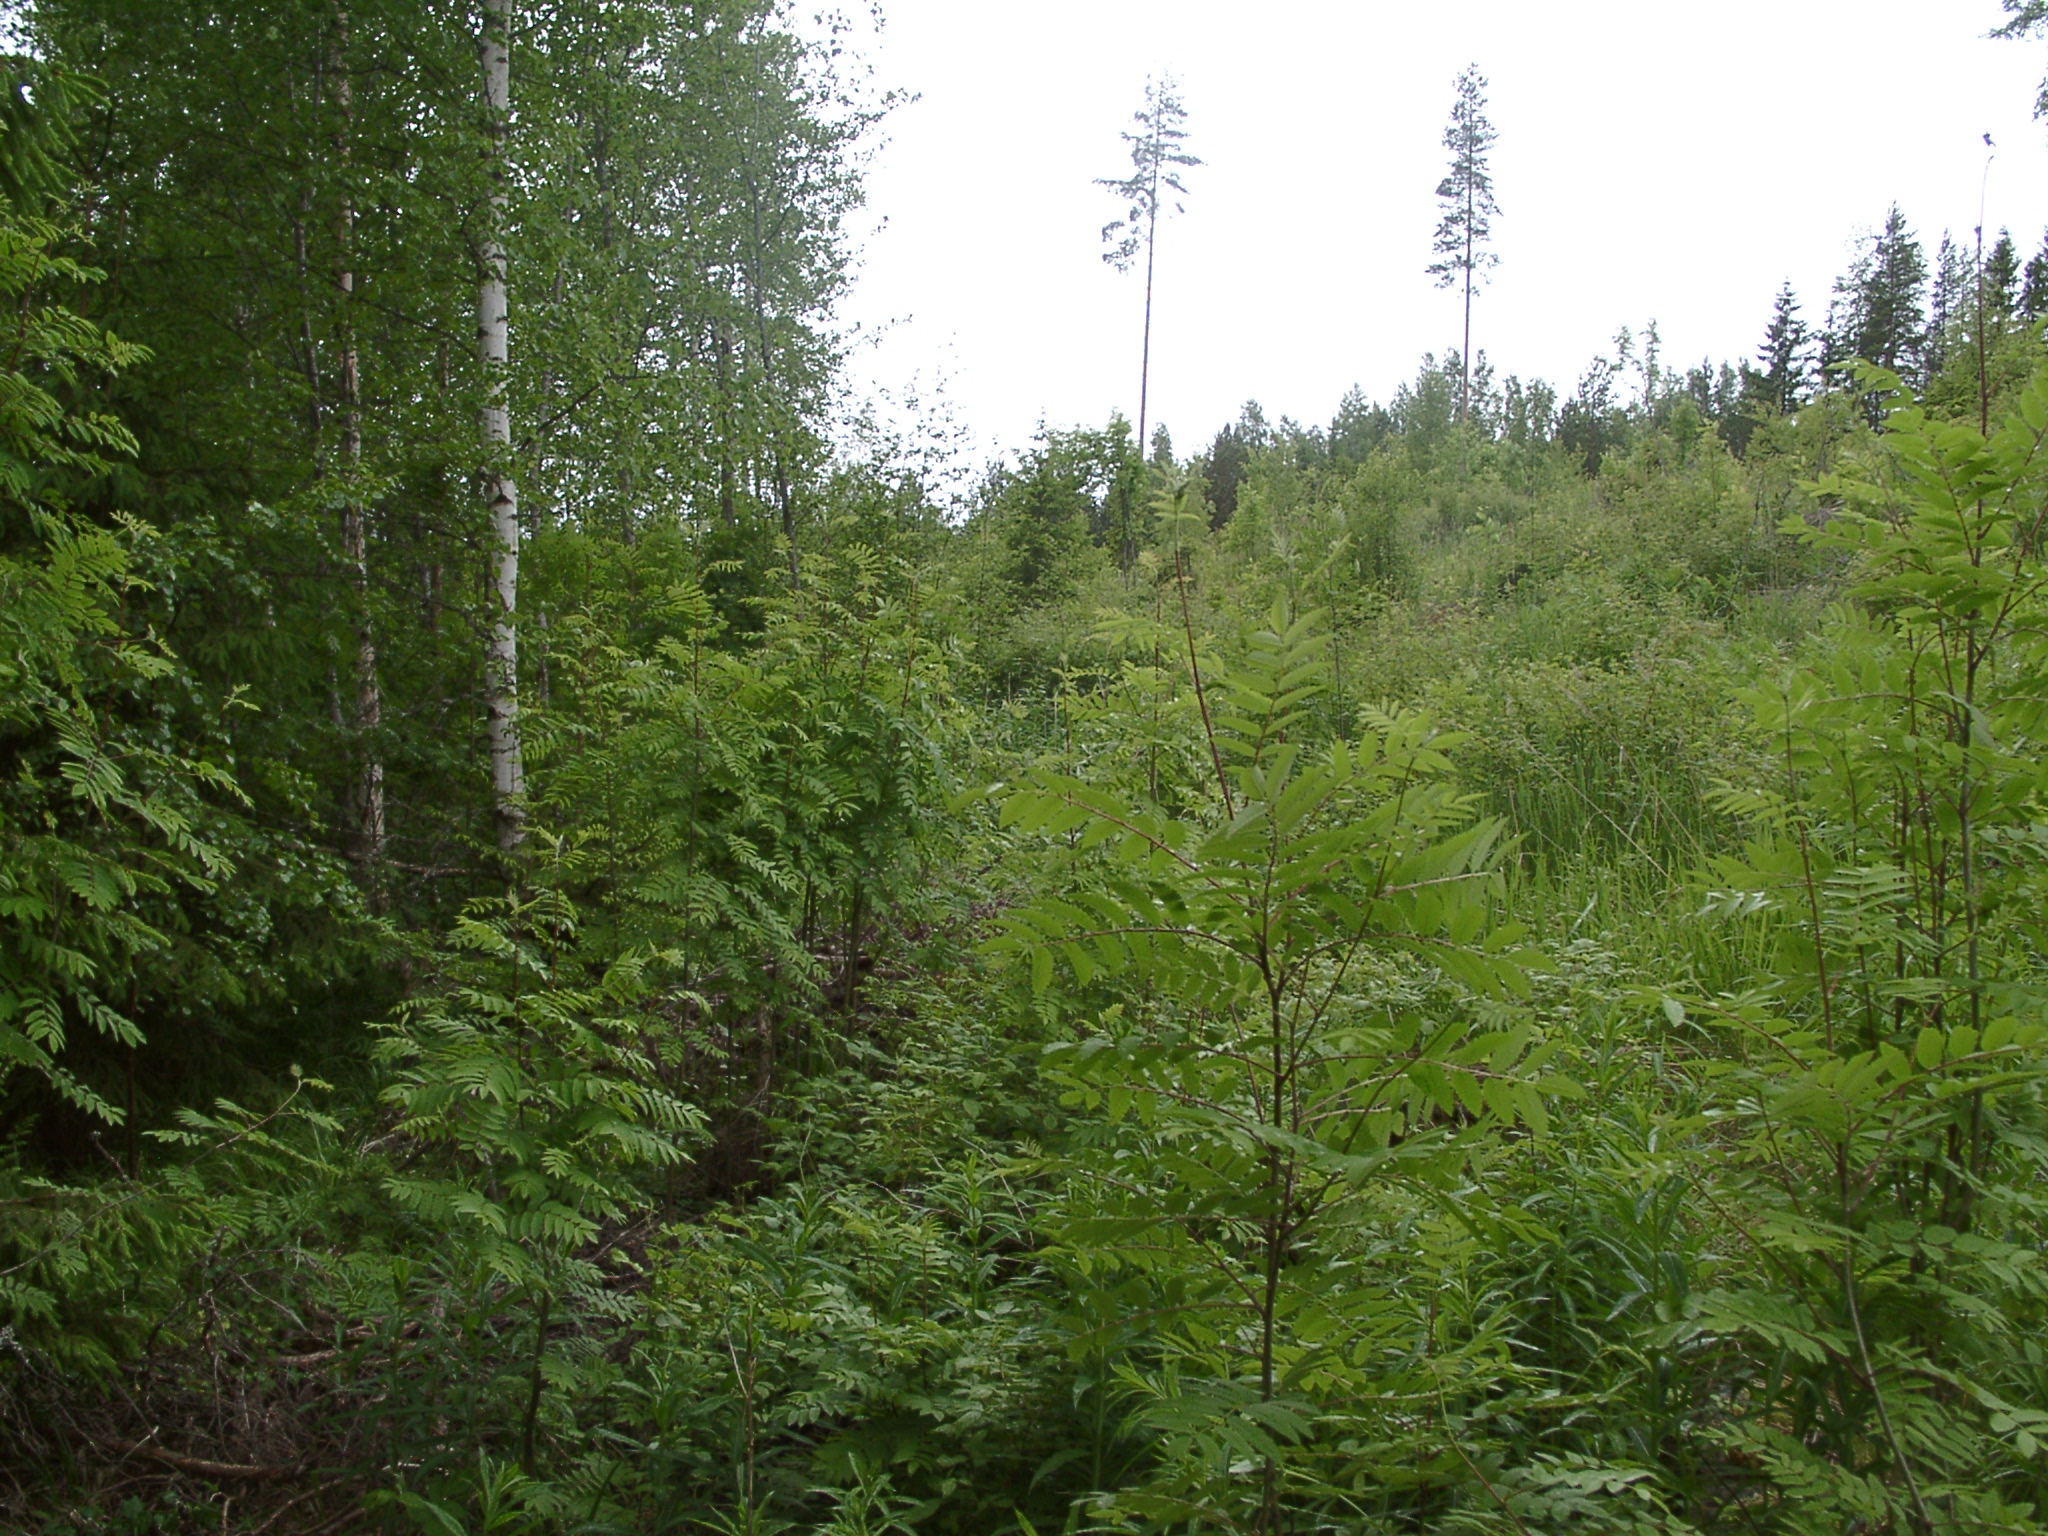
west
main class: Shrubland
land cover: Shrubland with sparse tree cover
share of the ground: 25 - 50 %
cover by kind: herbaceous plants 50 %, shrubs 40 %, broadleaved forest trees 5 %, consolidated bare surface 5 %
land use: Forestry
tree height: < 5 m
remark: Clear cut
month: June
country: FI
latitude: 61.6080
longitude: 24.7125
